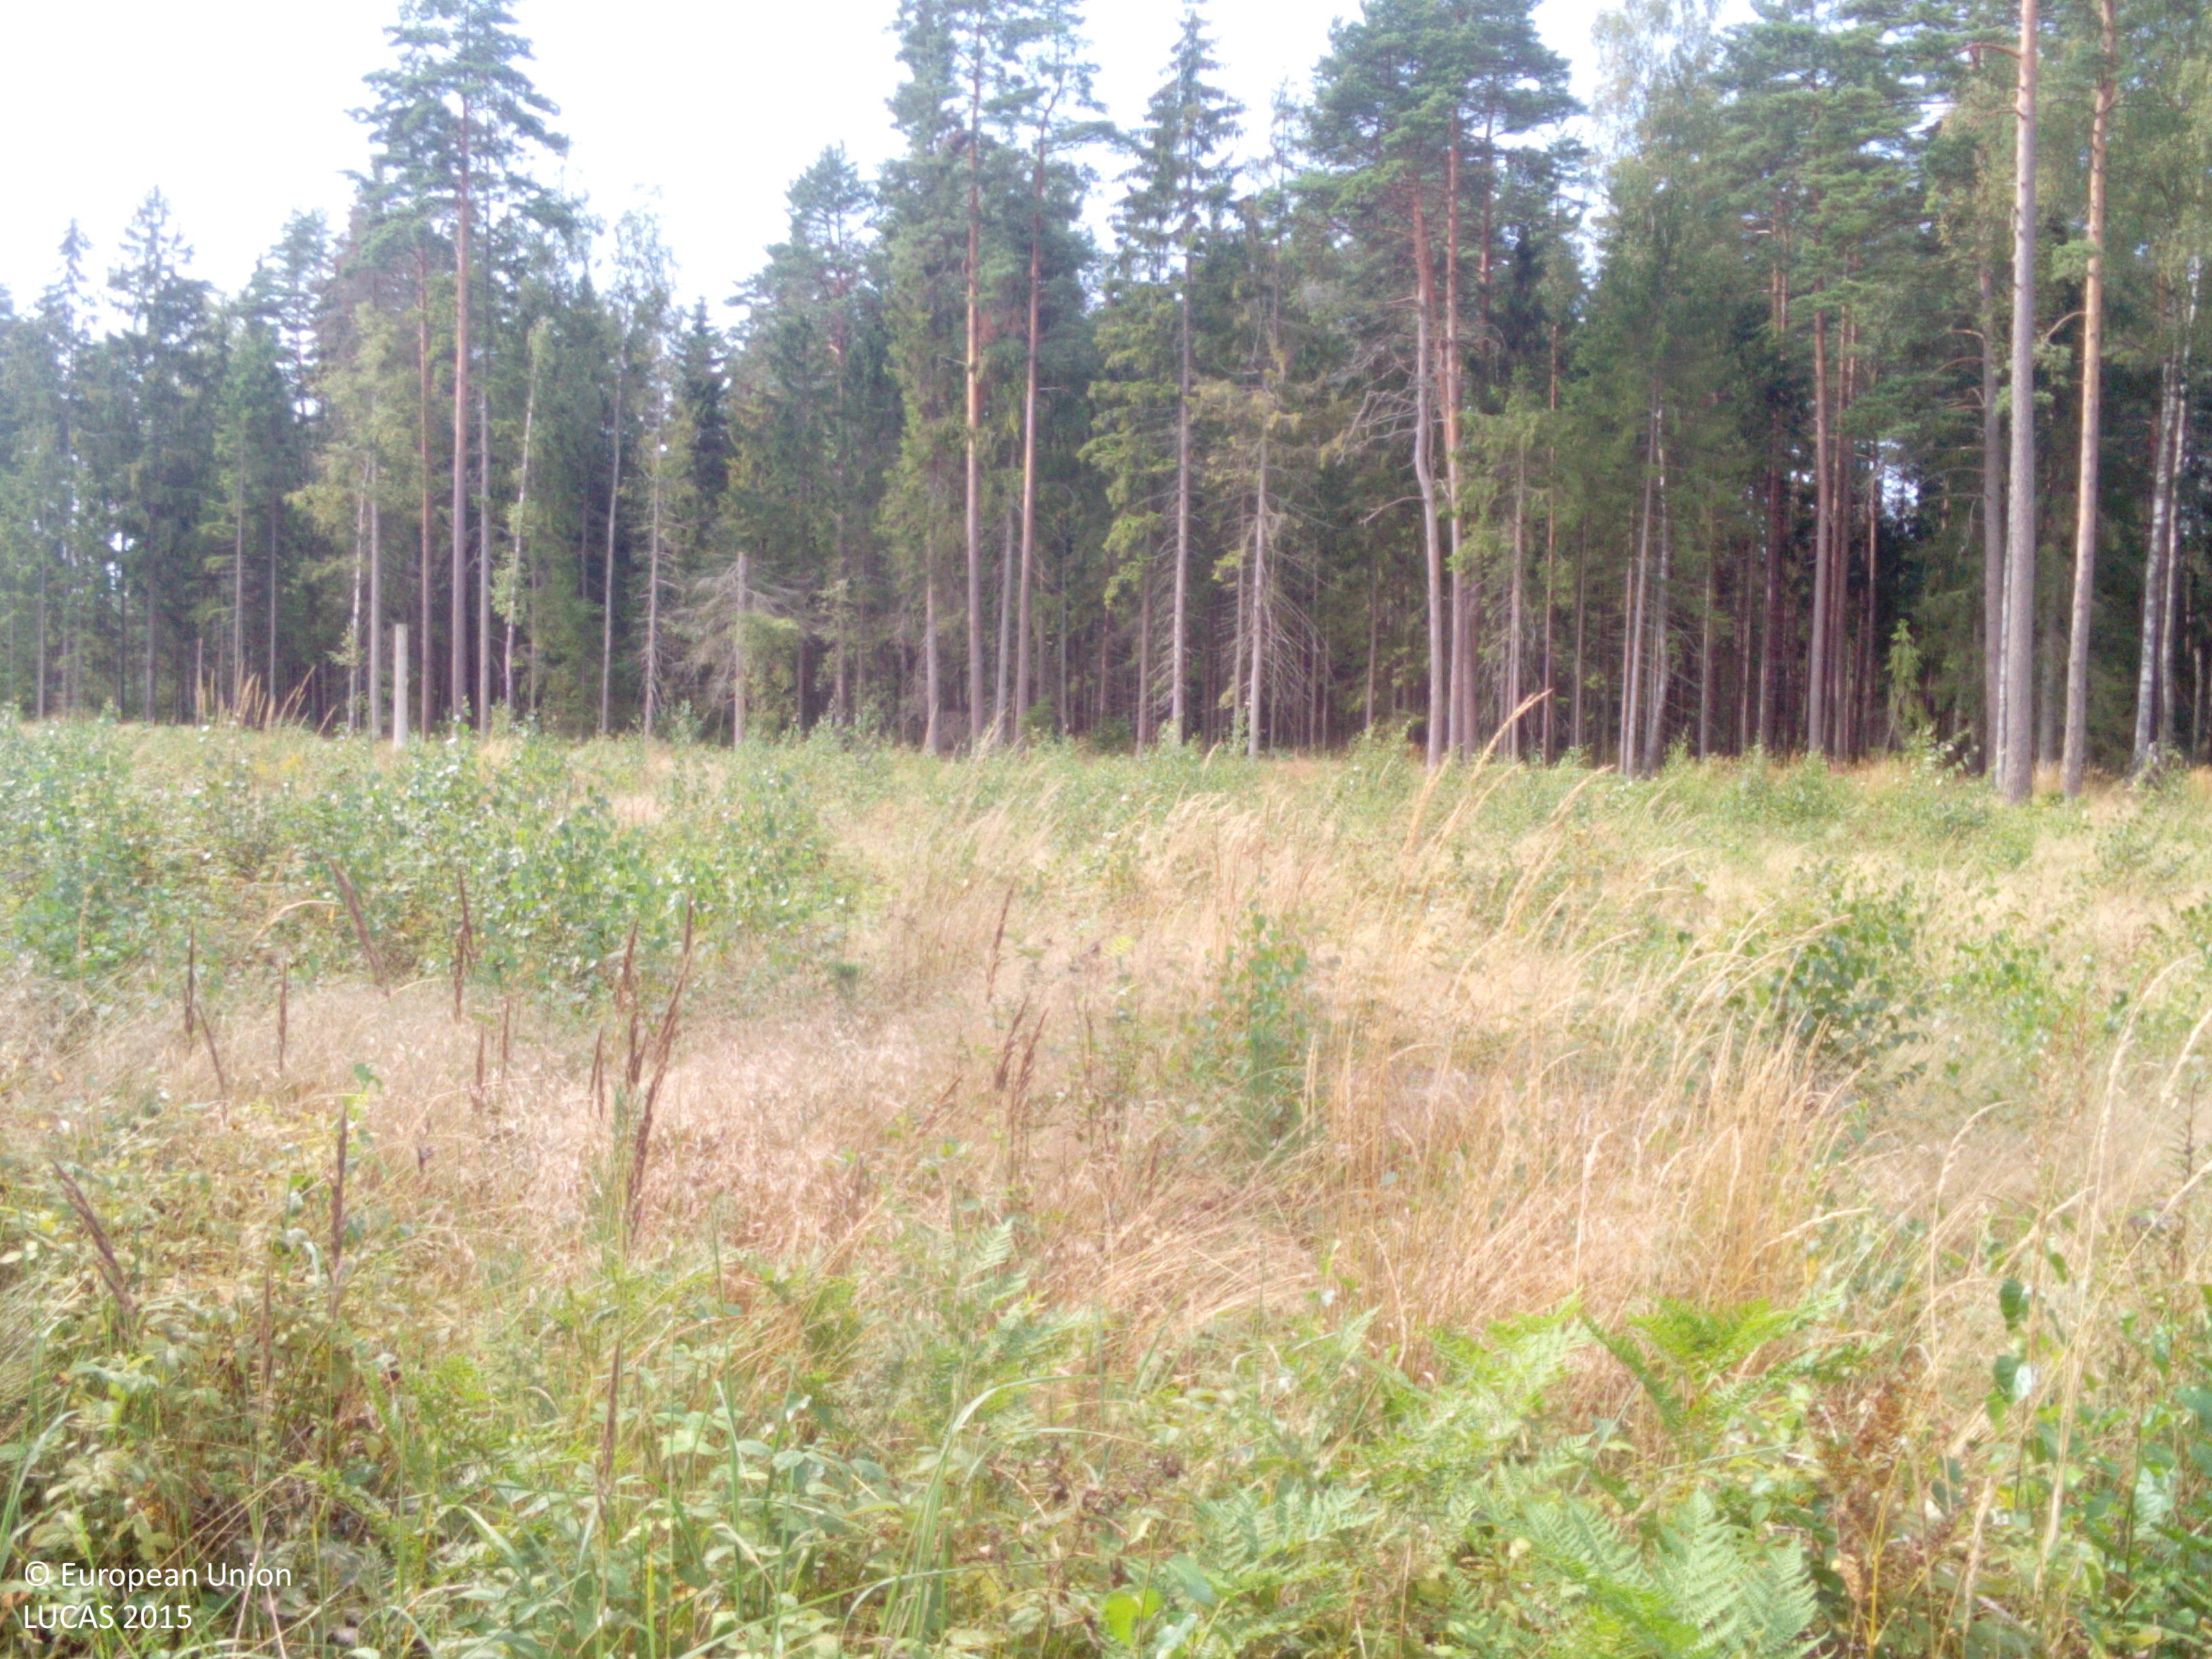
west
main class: Grassland
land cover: Grassland with sparse tree/shrub cover
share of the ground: > 75 %
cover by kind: herbaceous plants 85 %, shrubs 10 %, broadleaved forest trees 5 %
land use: Forestry
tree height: < 5 m
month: August
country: LV
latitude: 56.3305
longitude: 21.2147
